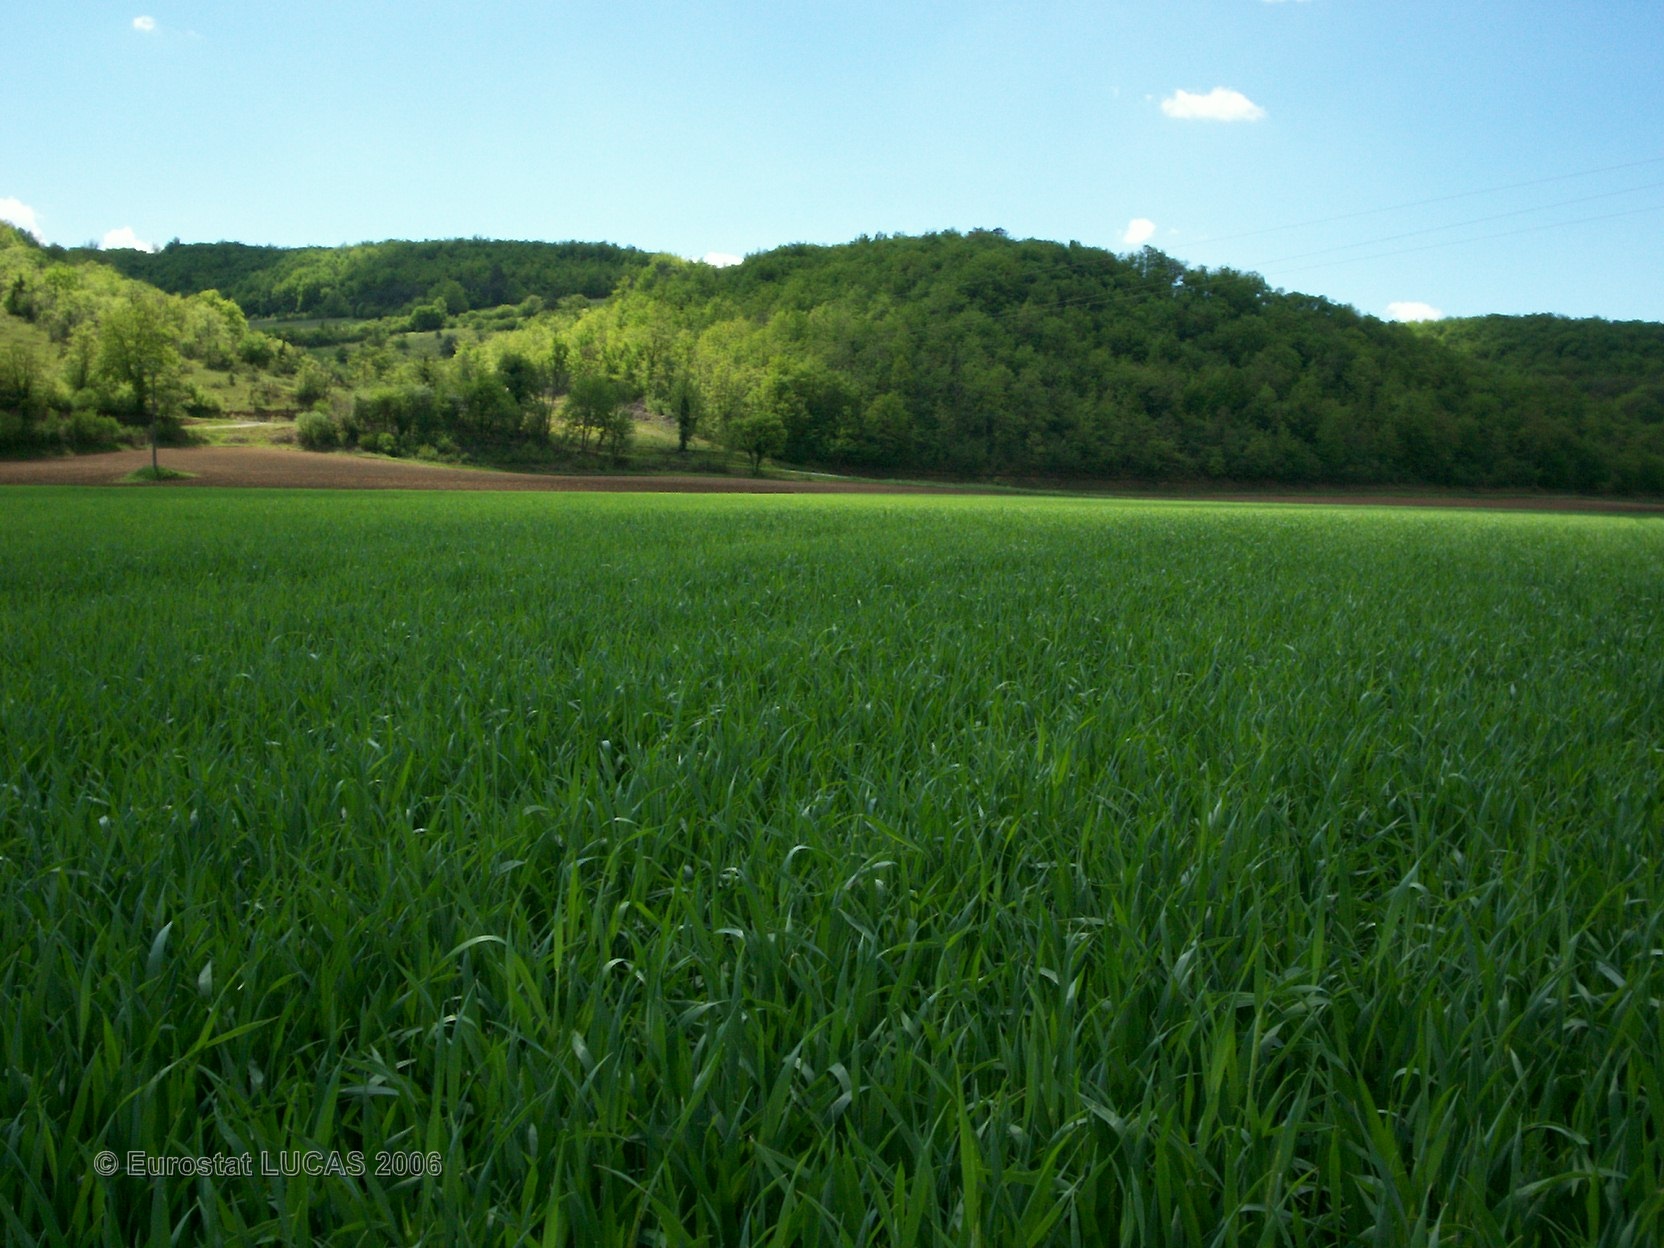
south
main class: Cropland
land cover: Triticale
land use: Agriculture (excluding fallow land and kitchen gardens)
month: May
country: FR
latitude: 45.0517
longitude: 1.2713
